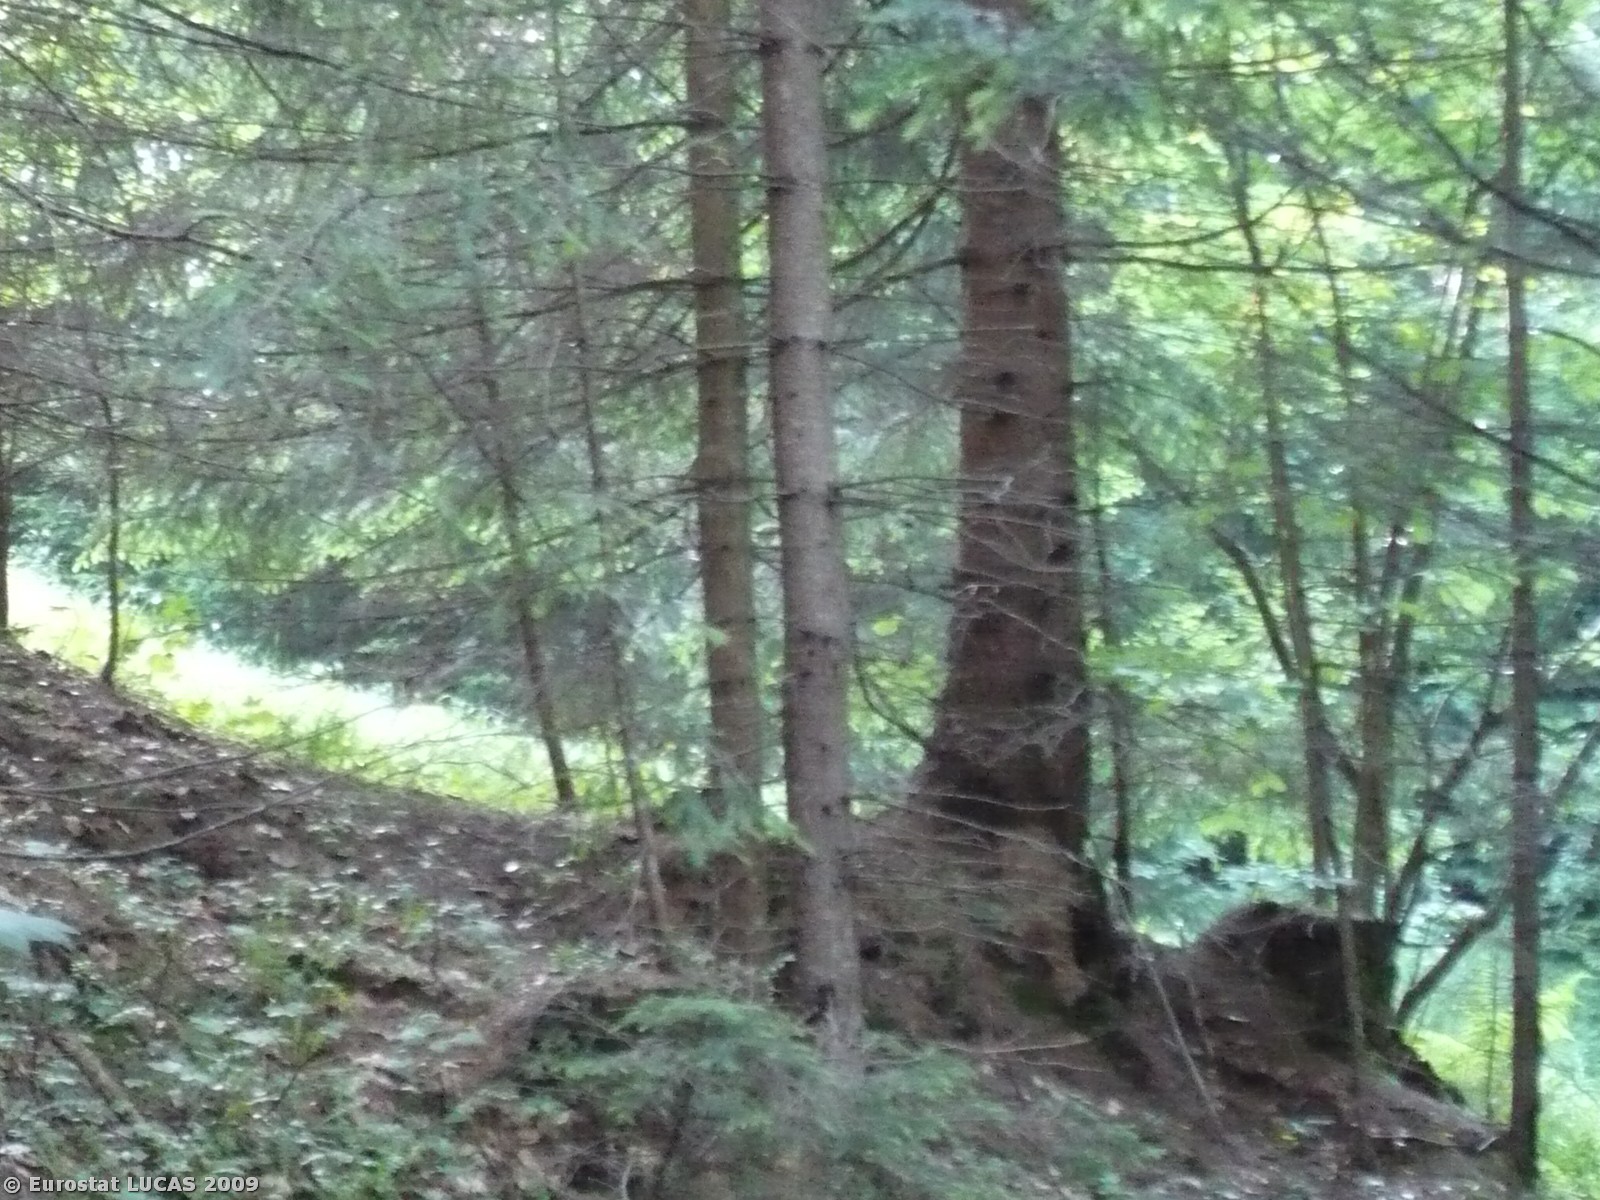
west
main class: Woodland
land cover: Coniferous woodland
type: alpine coniferous forest
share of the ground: > 75 %
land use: Forestry
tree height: > 5 m
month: June
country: SI
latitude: 46.4816
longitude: 13.8136
